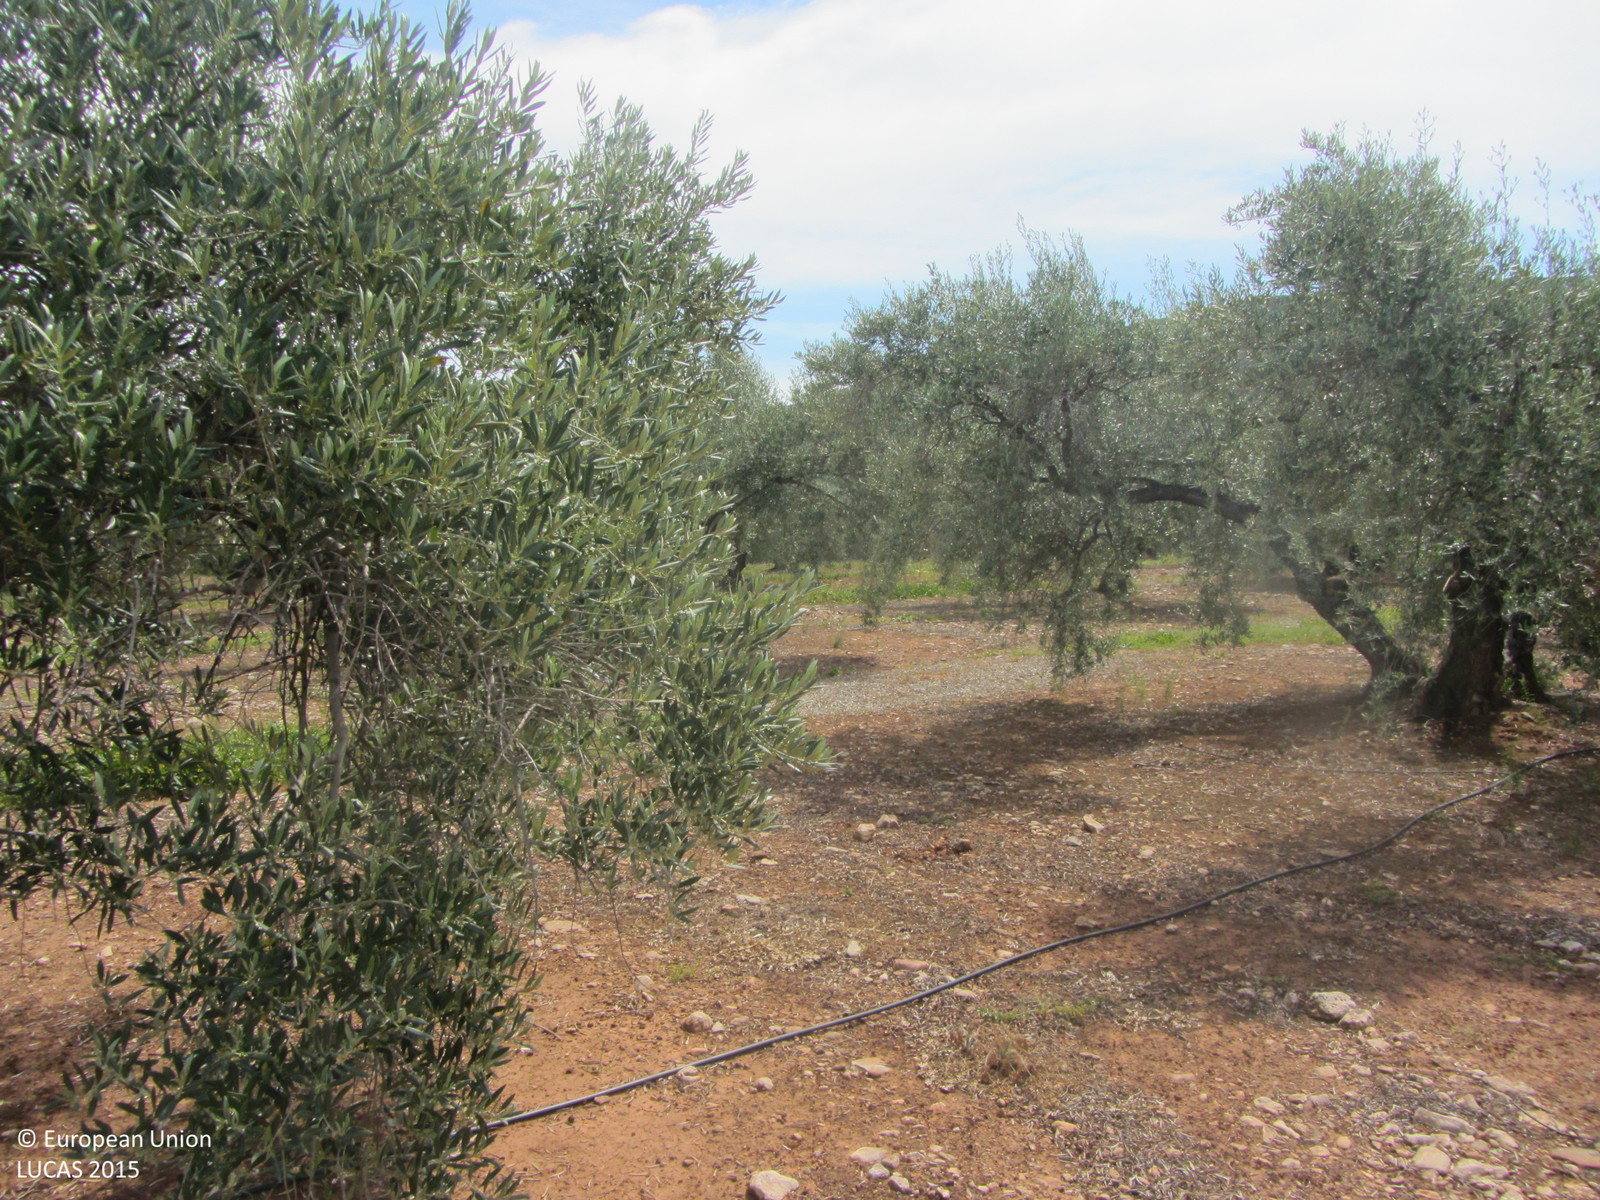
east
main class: Cropland
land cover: Olive groves
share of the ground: 25 - 50 %
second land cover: Spontaneously vegetated surfaces
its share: 10 - 25 %
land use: Agriculture (excluding fallow land and kitchen gardens)
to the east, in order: Olive groves; Spontaneously vegetated surfaces
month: May
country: ES
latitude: 38.3257
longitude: -3.0763
